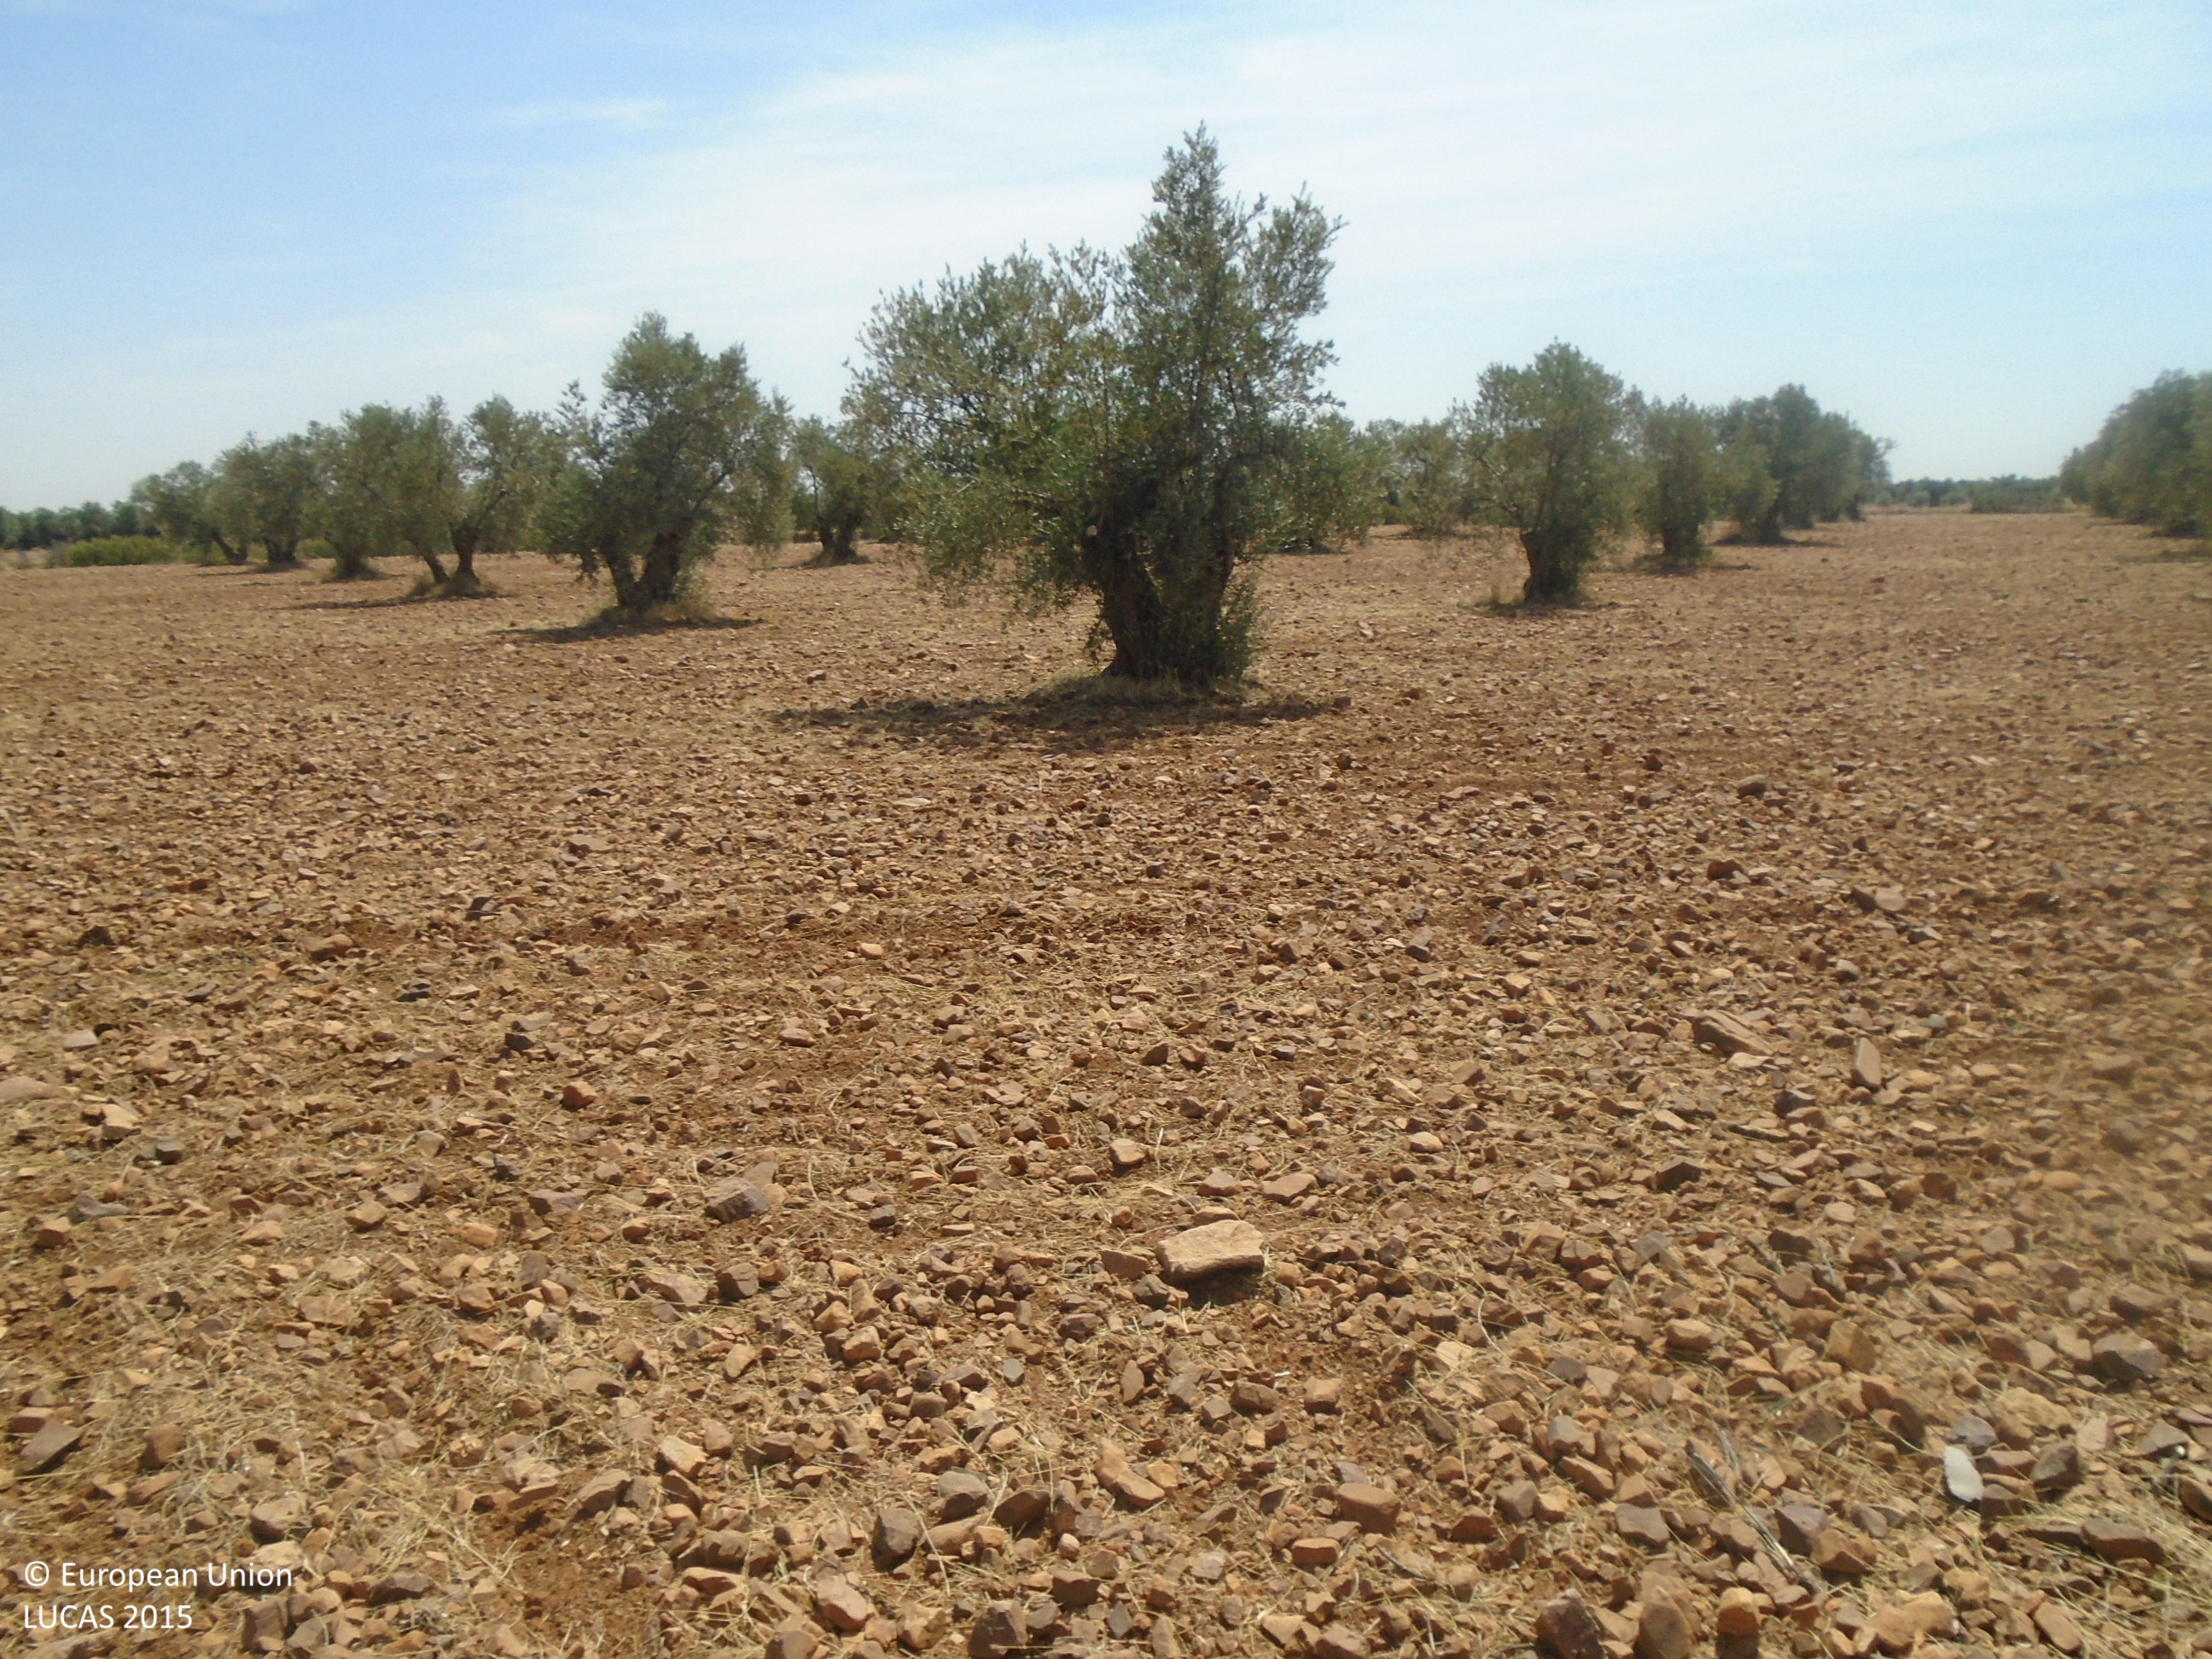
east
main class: Cropland
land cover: Olive groves
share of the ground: 25 - 50 %
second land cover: Other bare soil
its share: > 75 %
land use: Agriculture (excluding fallow land and kitchen gardens)
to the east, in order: Olive groves; Other bare soil; Shrubland without tree cover; Other bare soil; Rivers and streams; Grass margins; Olive groves
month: July
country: ES
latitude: 39.4072
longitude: -3.5988
